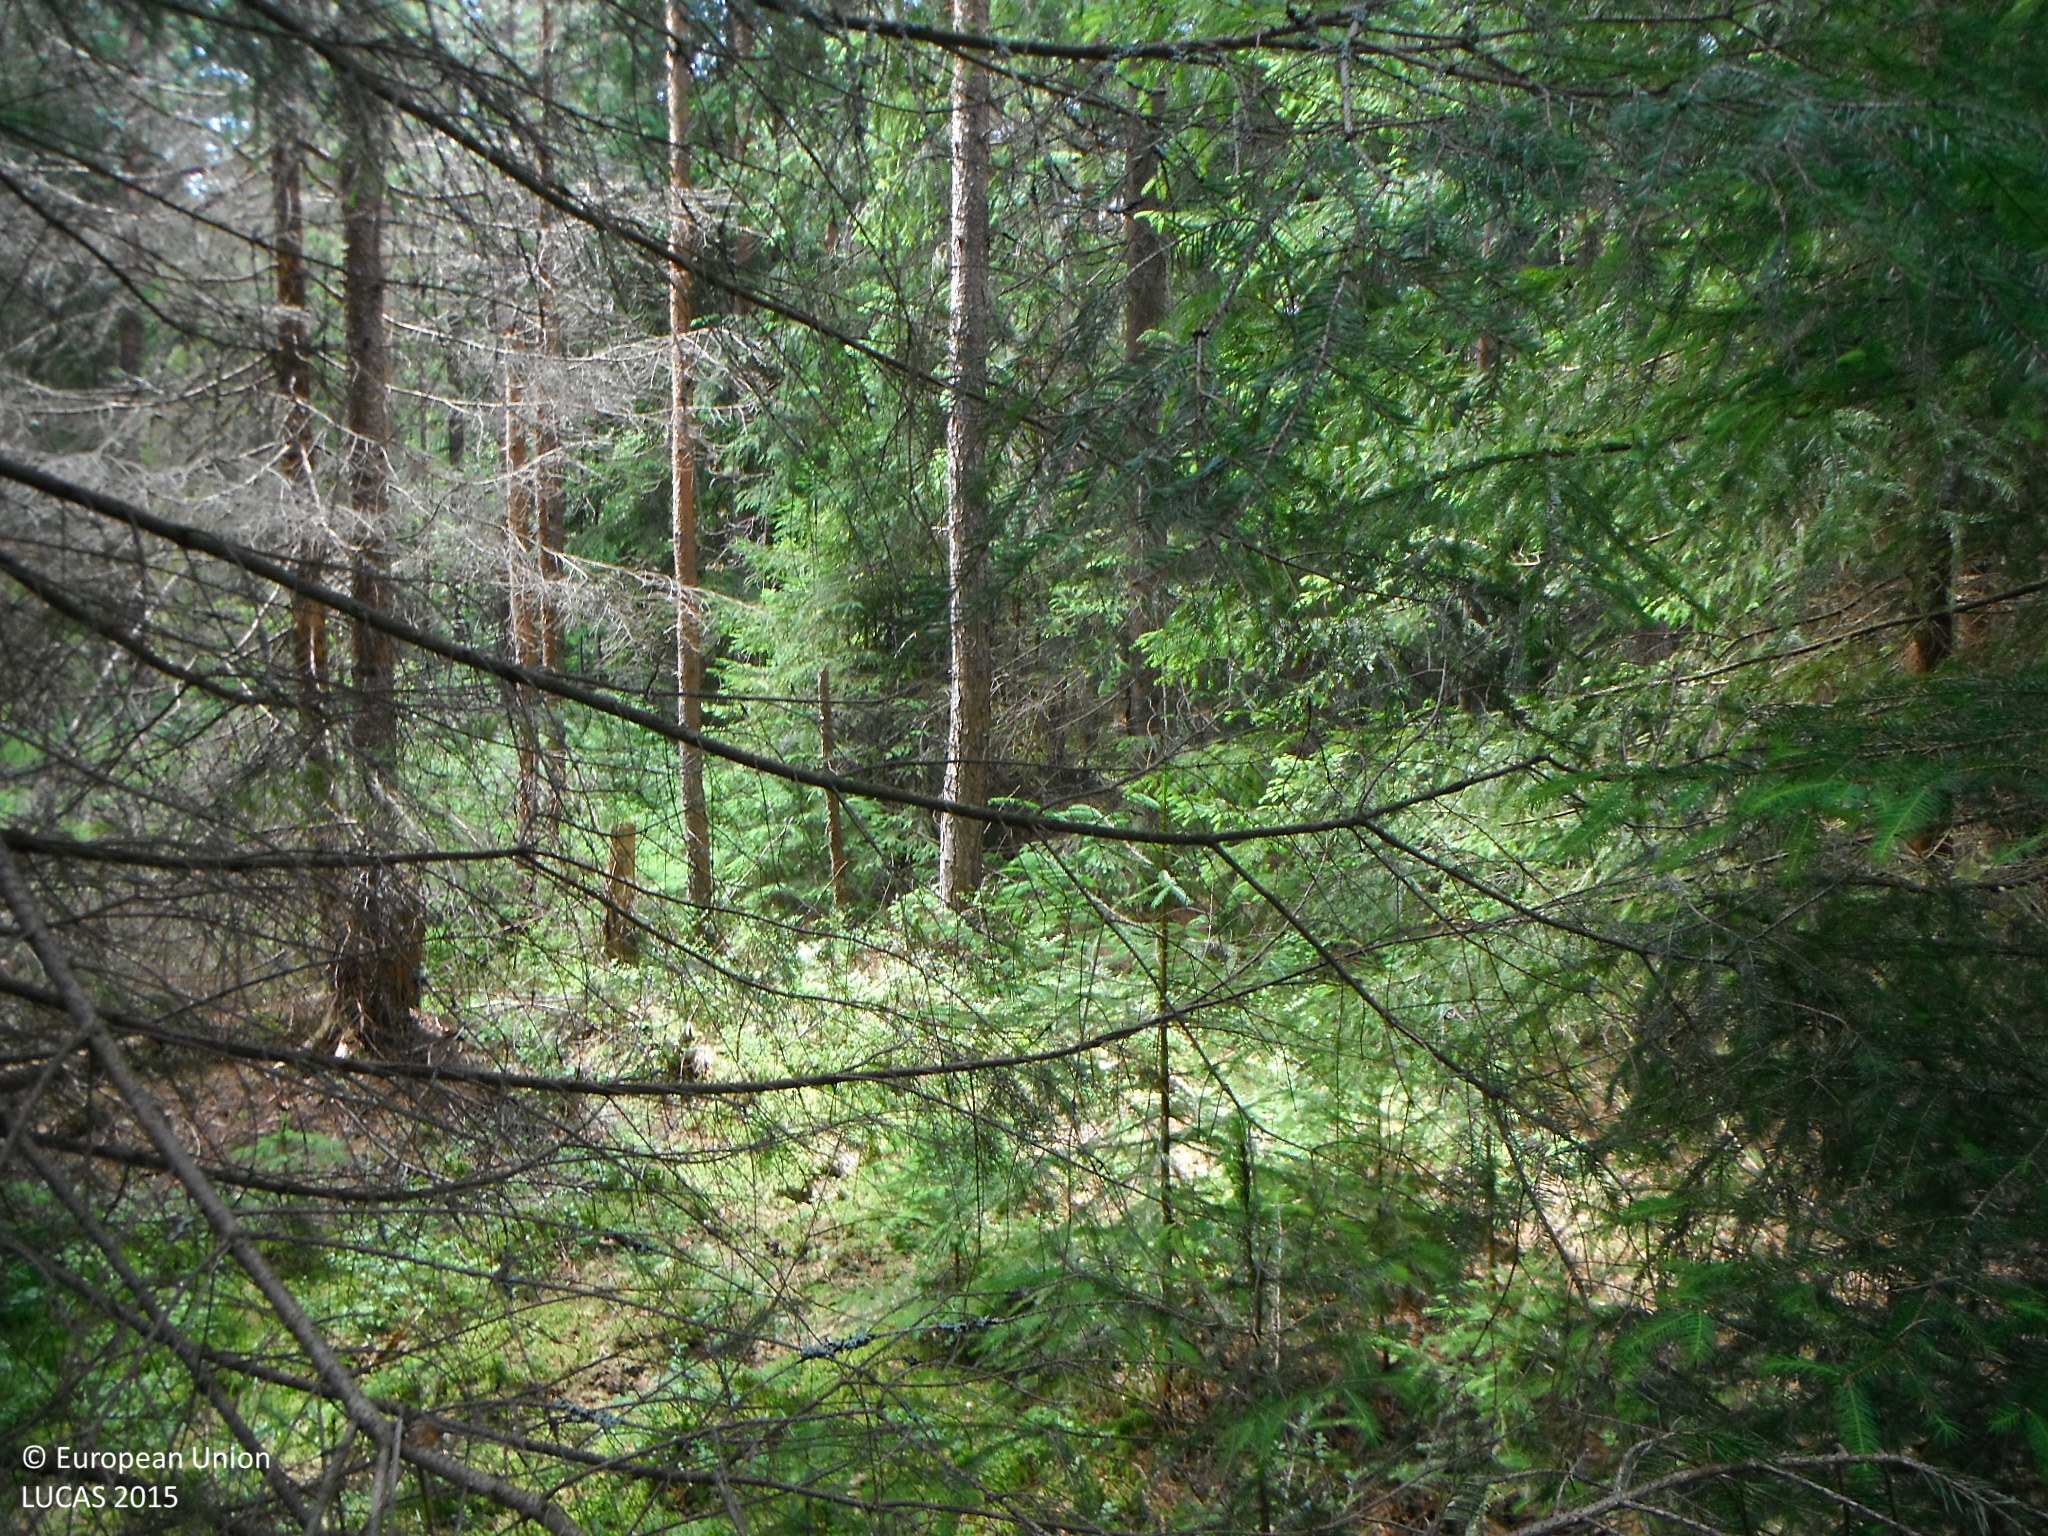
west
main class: Woodland
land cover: Spruce dominated coniferous woodland
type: alpine coniferous forest
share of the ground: > 75 %
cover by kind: coniferous forest trees 100 %
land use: Forestry
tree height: > 5 m
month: July
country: SK
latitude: 49.4012
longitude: 19.7717
